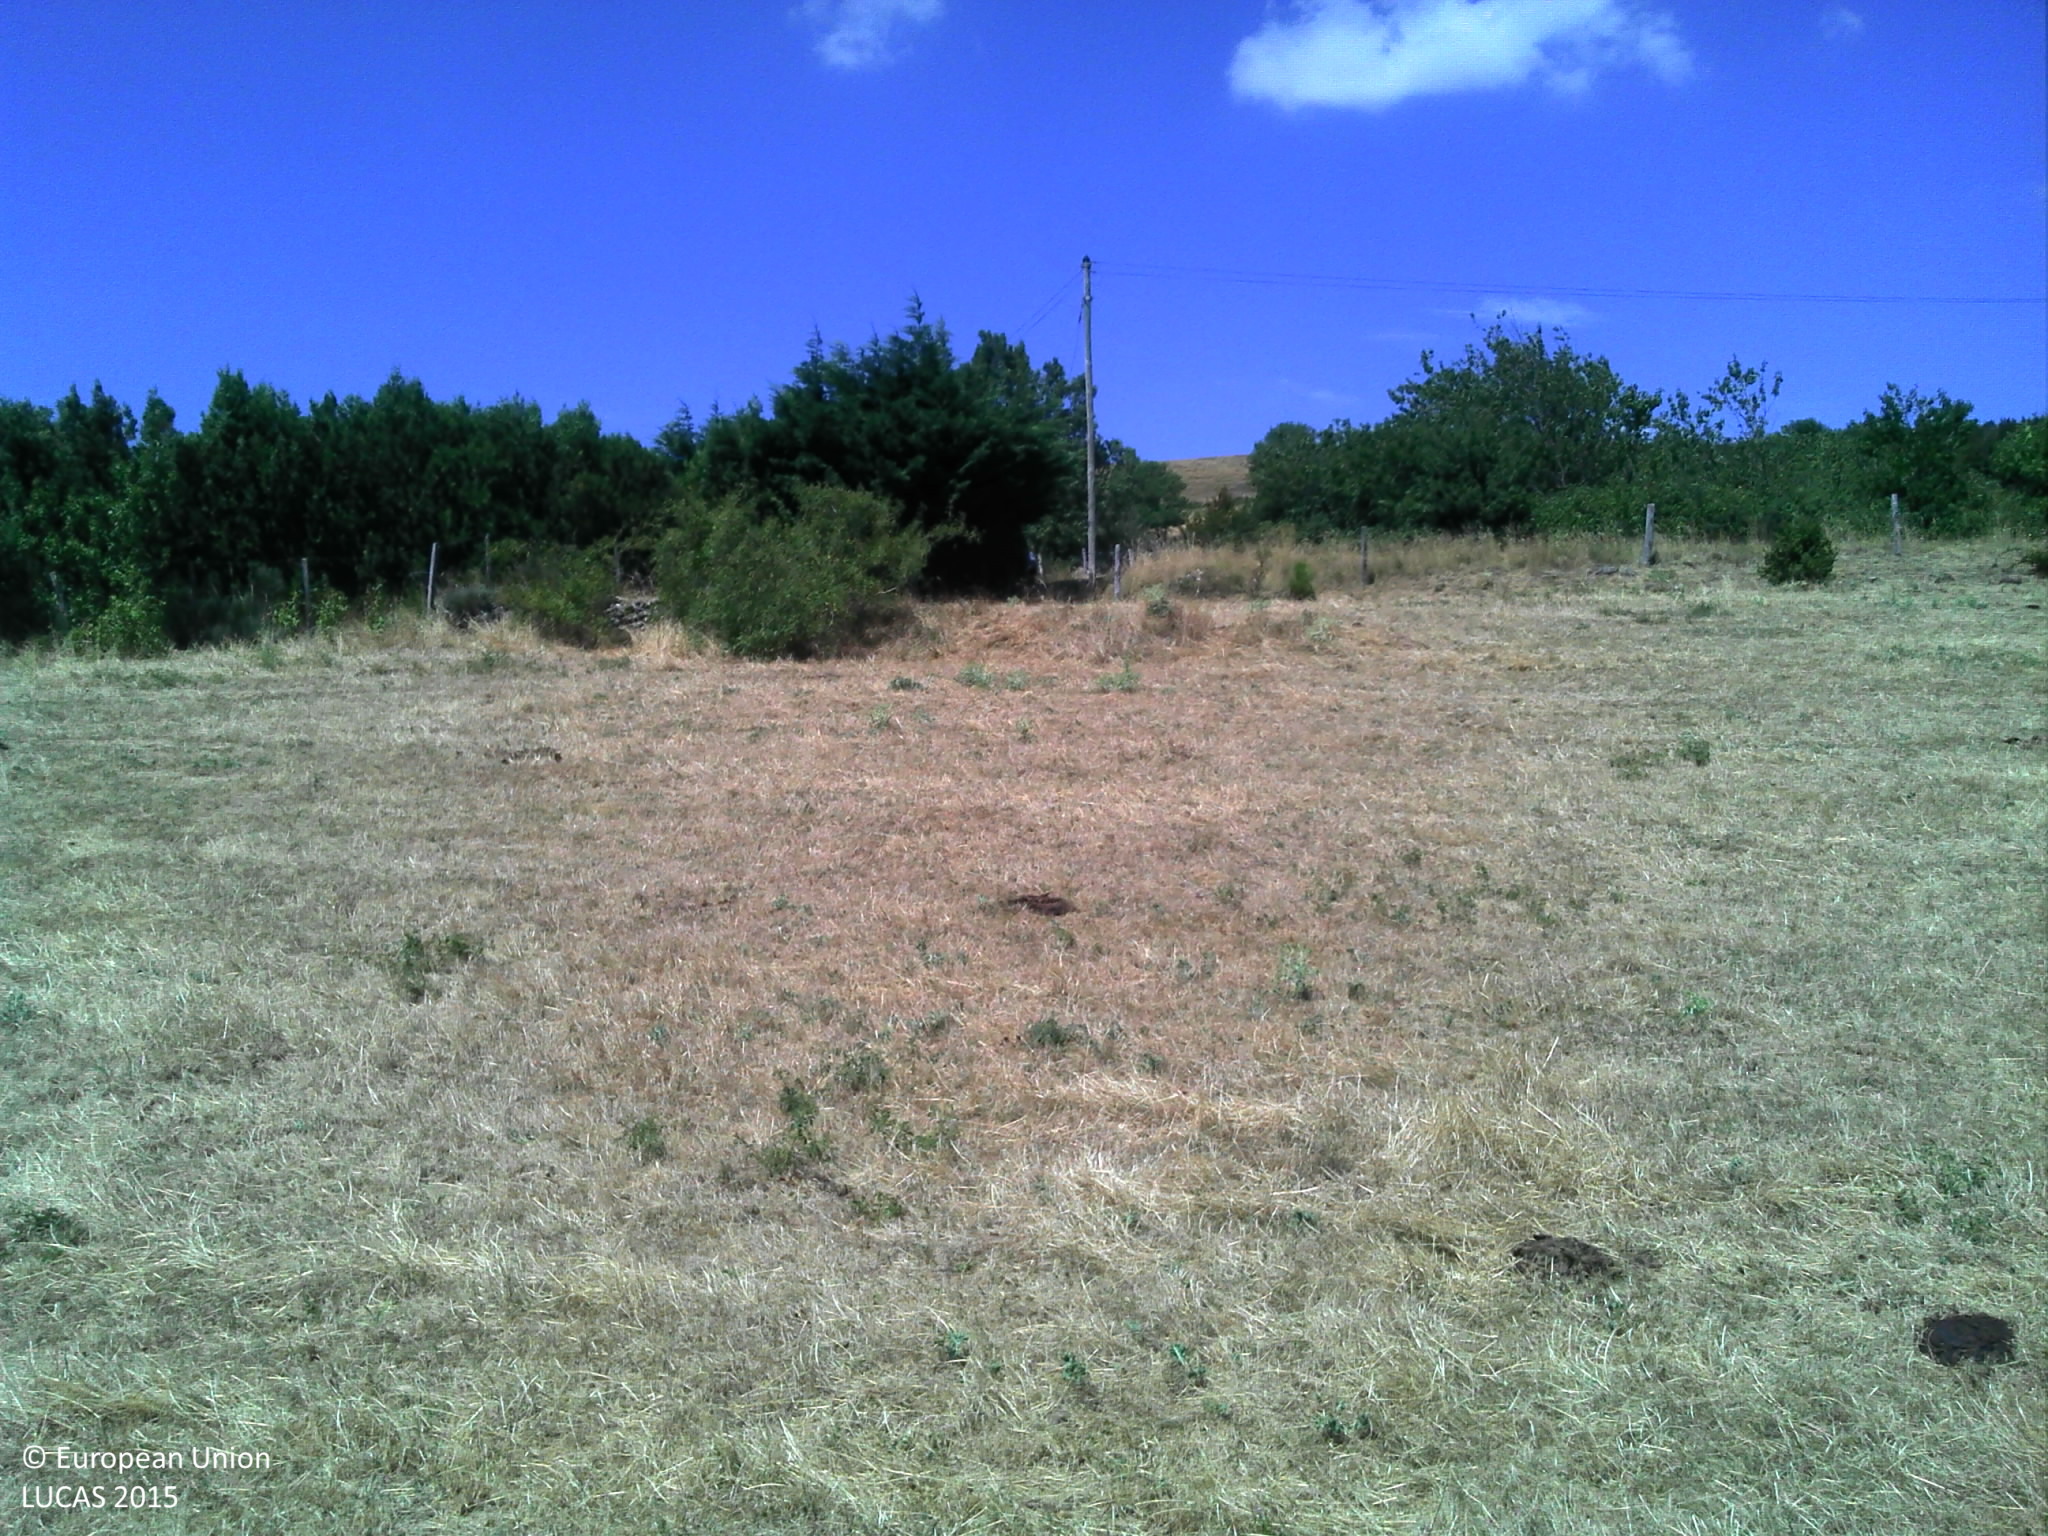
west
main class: Grassland
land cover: Grassland with sparse tree/shrub cover
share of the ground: > 75 %
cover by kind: herbaceous plants 95 %, broadleaved forest trees 5 %
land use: Agriculture (excluding fallow land and kitchen gardens)
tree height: < 5 m
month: July
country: FR
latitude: 44.6782
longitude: 4.5689
